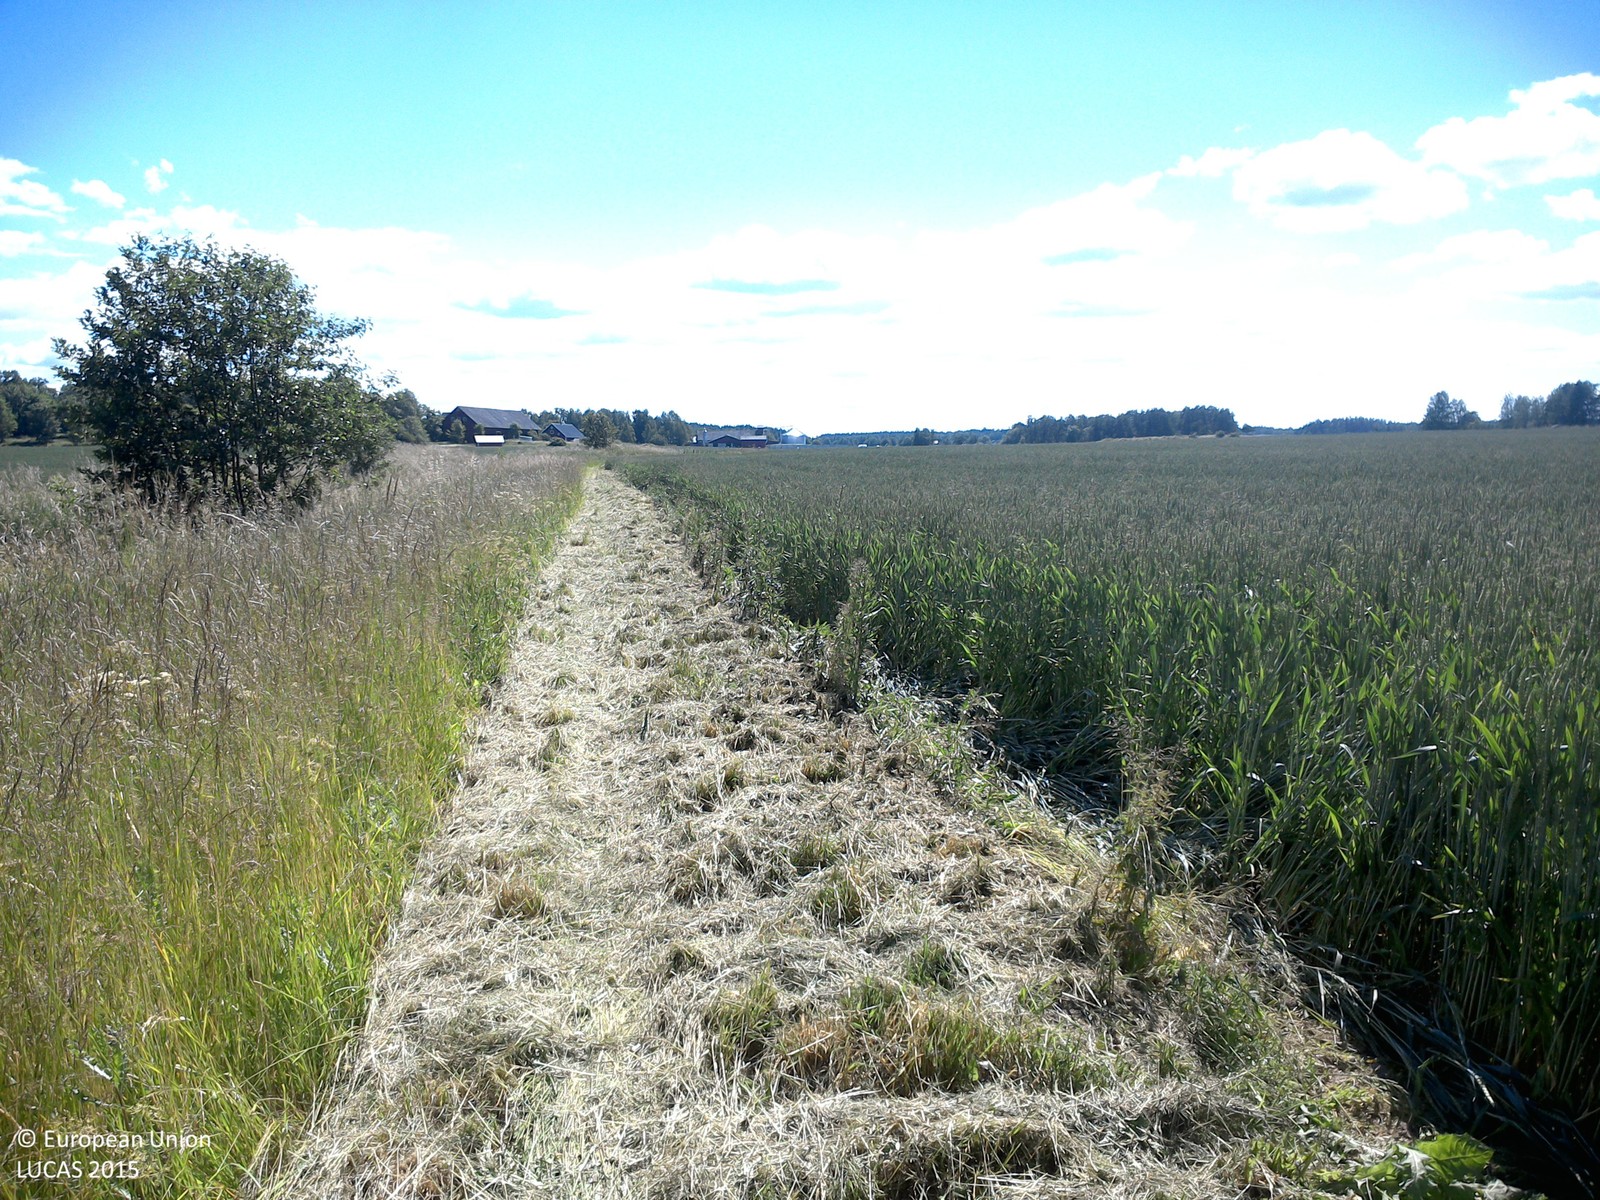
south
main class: Cropland
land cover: Common wheat
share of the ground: > 75 %
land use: Agriculture (excluding fallow land and kitchen gardens)
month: July
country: SE
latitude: 58.3616
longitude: 15.4468
